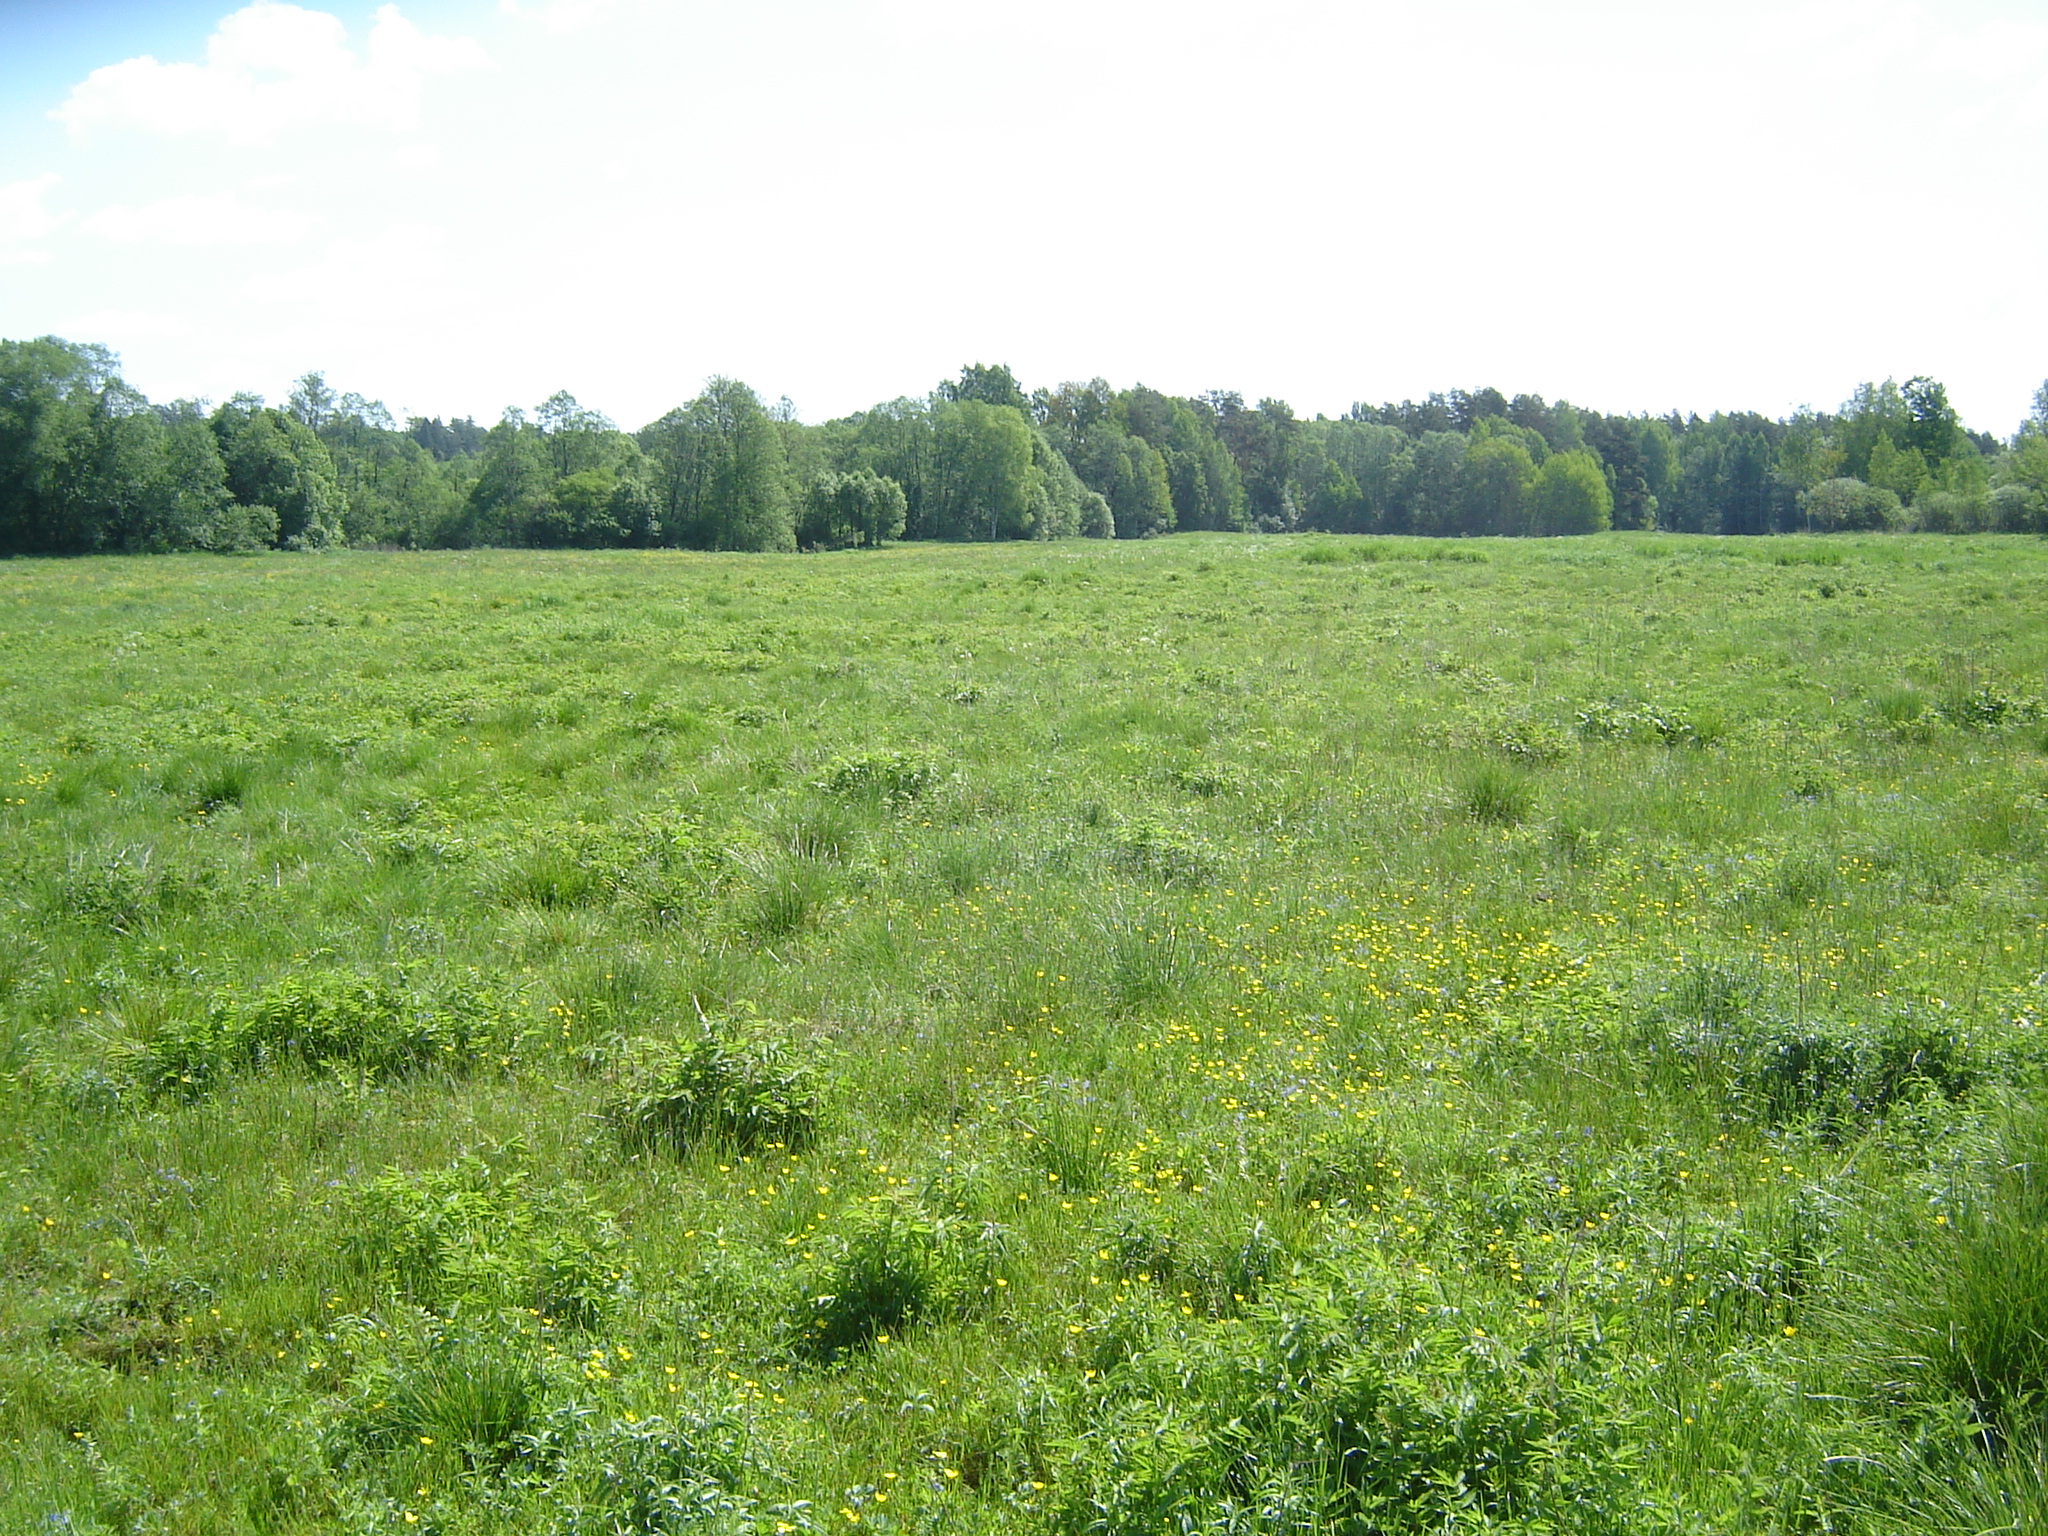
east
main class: Grassland
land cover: Spontaneously vegetated surfaces
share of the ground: > 75 %
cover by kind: herbaceous plants 100 %
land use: Semi-natural and natural areas not in use
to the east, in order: Spontaneously vegetated surfaces; Broadleaved woodland; Inland fresh running water; Broadleaved woodland; Grassland without tree/shrub cover
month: May
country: LT
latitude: 55.6831
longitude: 25.3077
